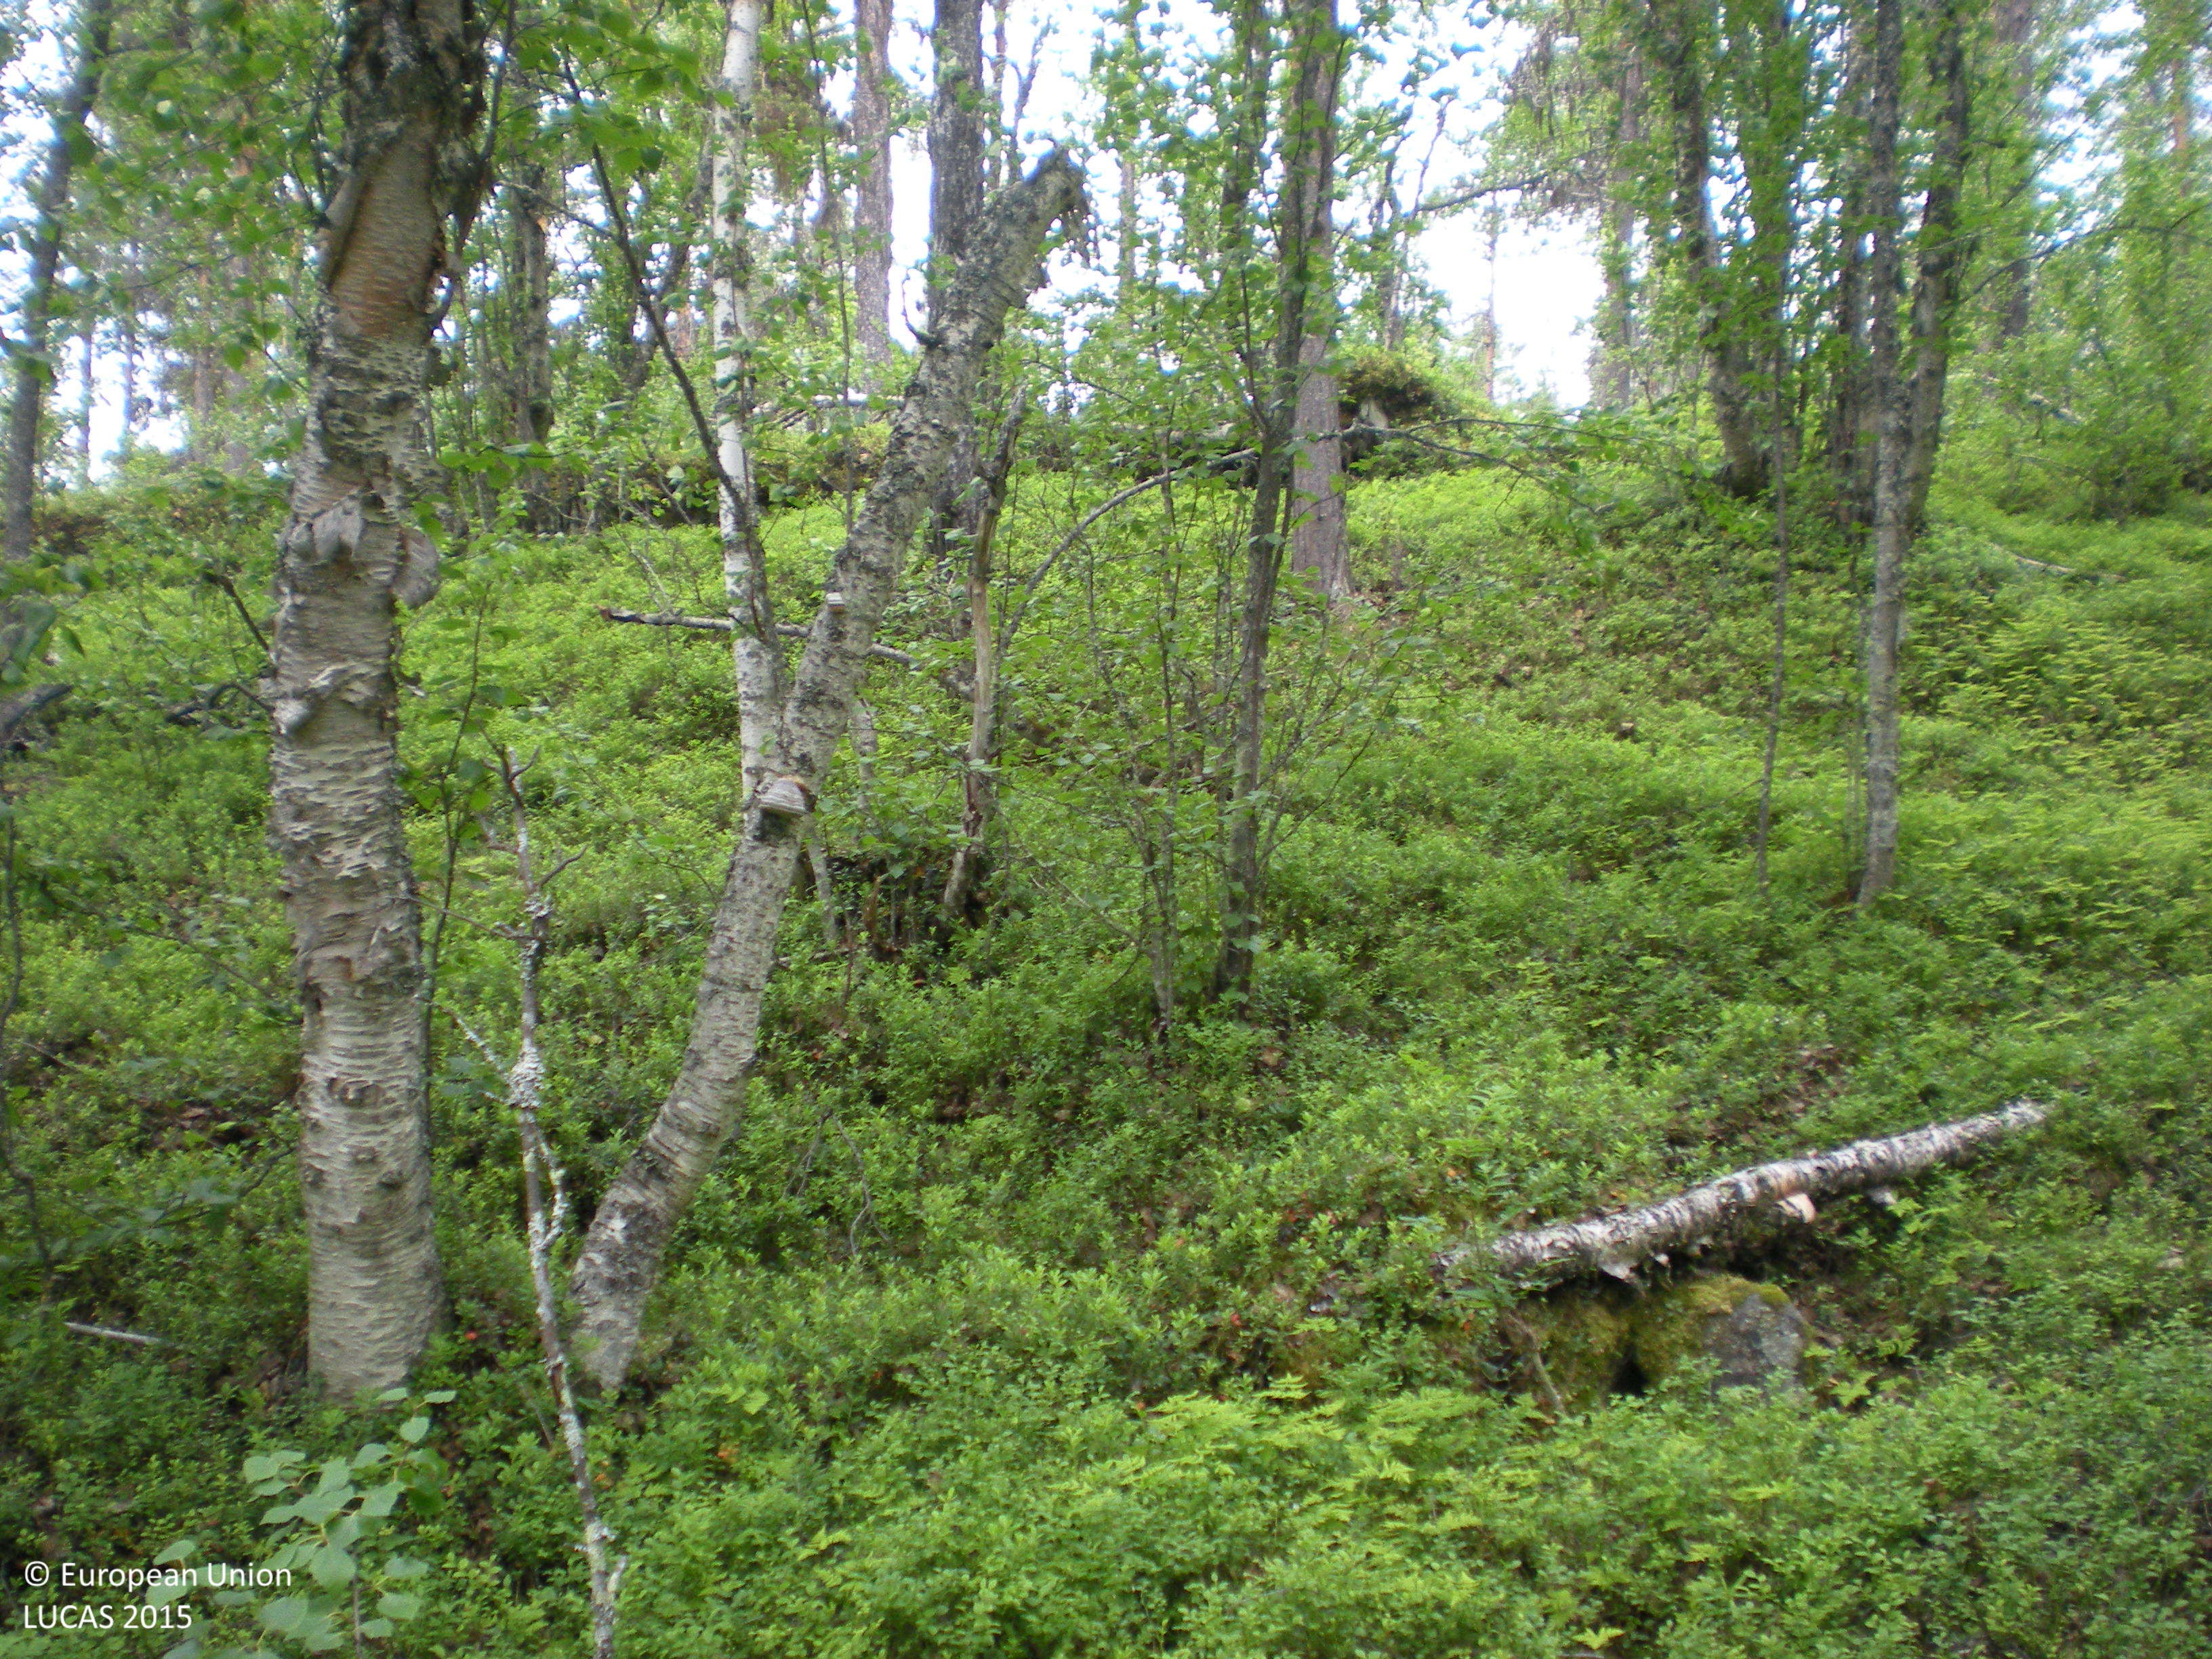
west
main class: Woodland
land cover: Pine dominated mixed woodland
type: boreal forest
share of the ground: 50 - 75 %
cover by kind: coniferous forest trees 35 %, broadleaved forest trees 35 %, shrubs 25 %, herbaceous plants 5 %
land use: Forestry
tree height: > 5 m
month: August
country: SE
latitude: 66.3190
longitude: 17.2945
